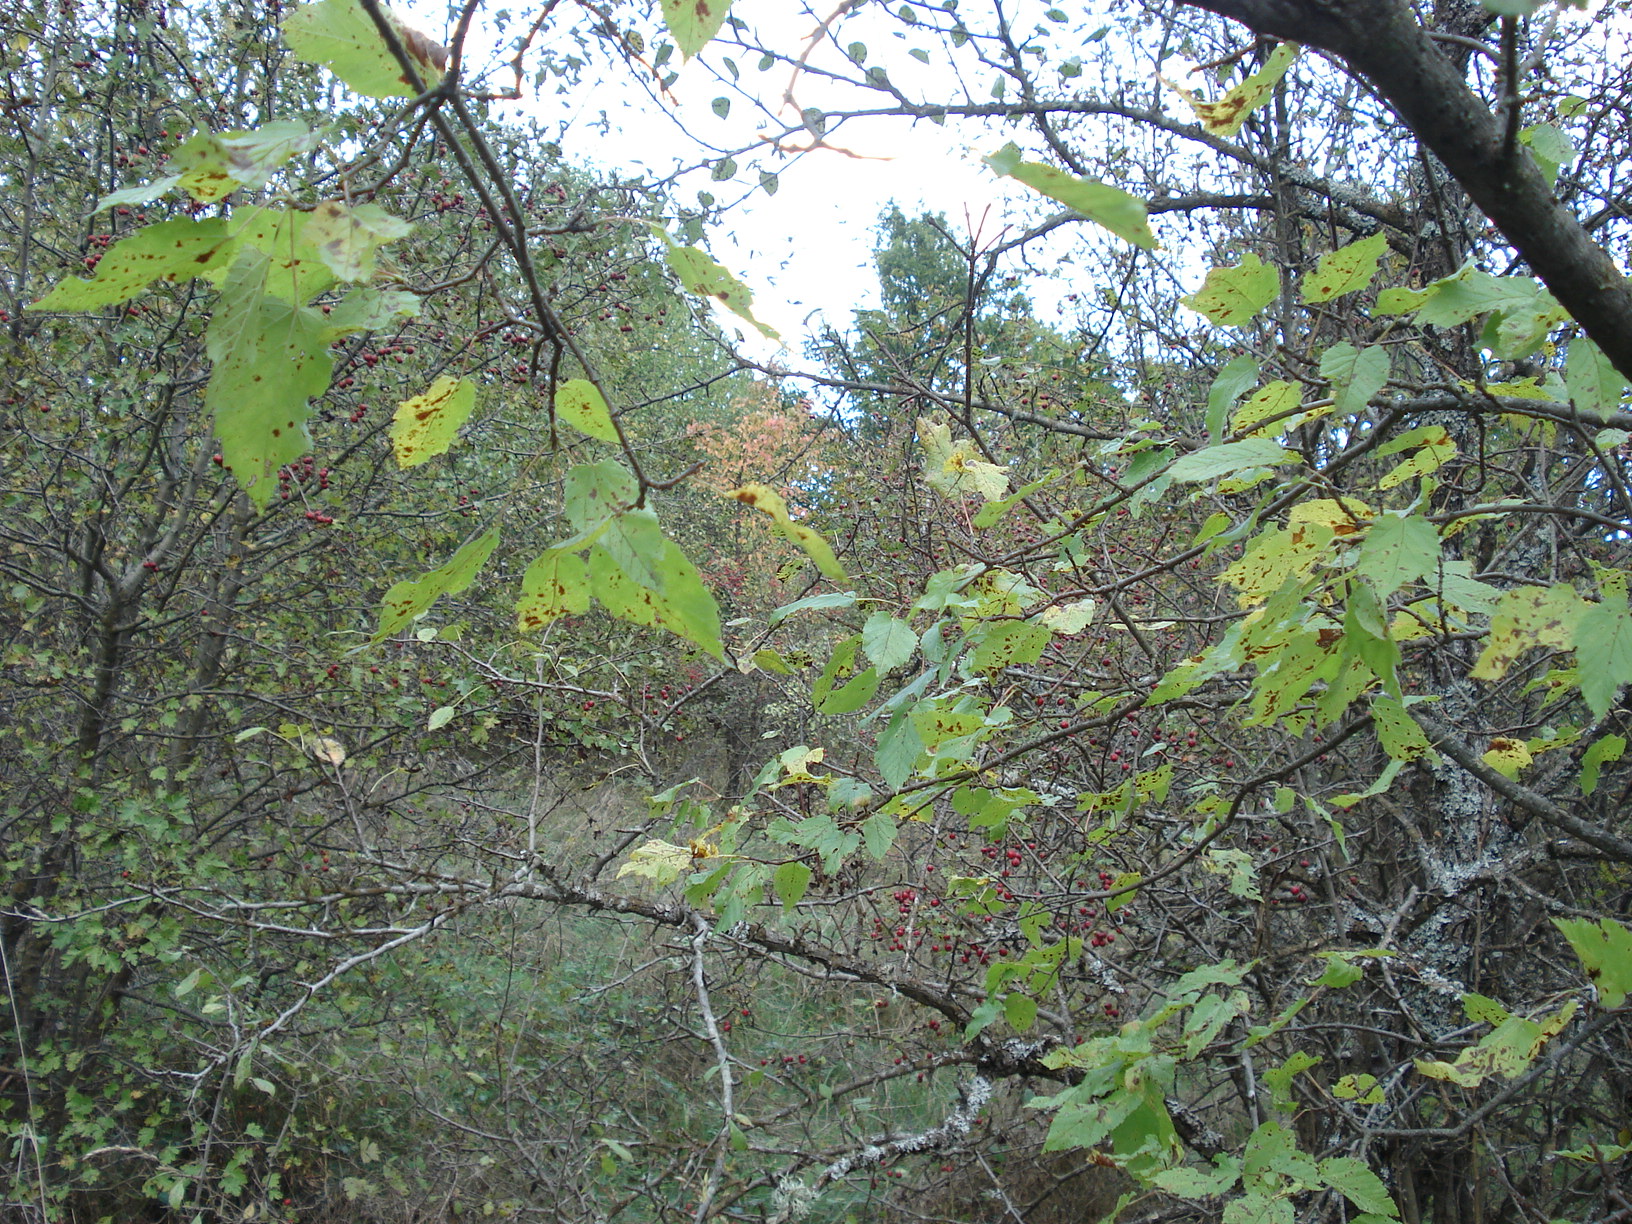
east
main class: Woodland
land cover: Broadleaved woodland
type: mesophytic deciduous forest
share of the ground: 50 - 75 %
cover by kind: broadleaved forest trees 60 %, herbaceous plants 30 %, shrubs 10 %
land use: Forestry
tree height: > 5 m
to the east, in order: Broadleaved woodland; Grassland without tree/shrub cover; Managed hedges; Grassland without tree/shrub cover; Shrubland with sparse tree cover; Grassland without tree/shrub cover
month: October
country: BG
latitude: 42.9632
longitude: 26.1623
